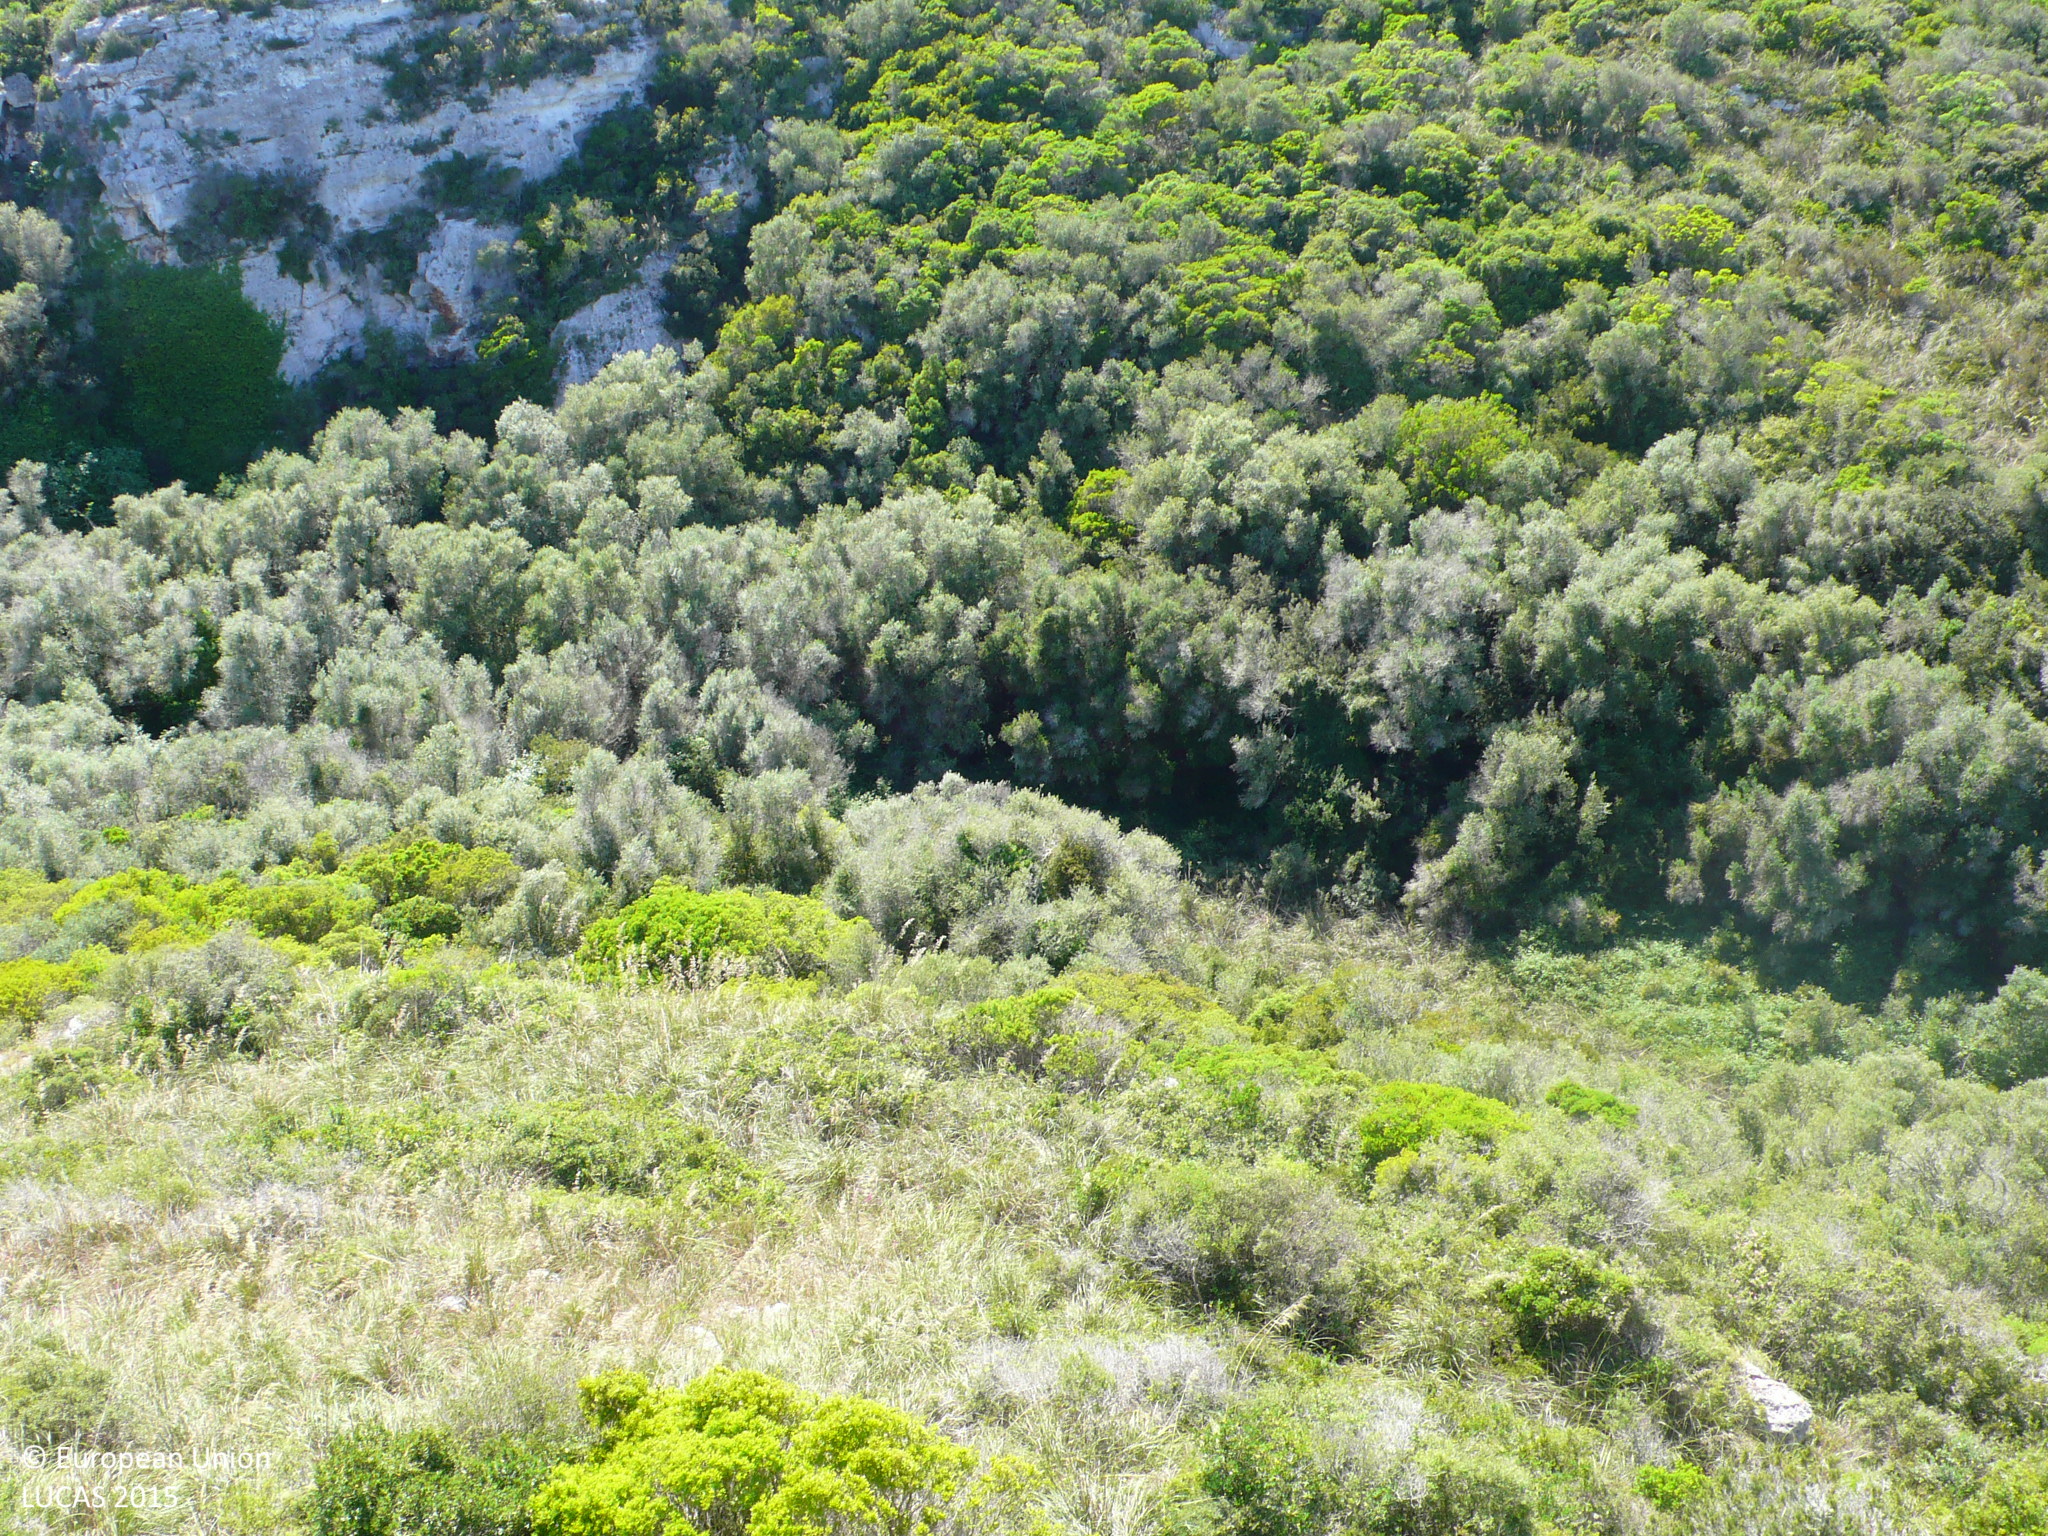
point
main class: Woodland
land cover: Broadleaved woodland
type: broadleaved evergreen forest
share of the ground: 50 - 75 %
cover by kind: broadleaved forest trees 50 %, shrubs 40 %, herbaceous plants 10 %
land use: Semi-natural and natural areas not in use
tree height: > 5 m
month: May
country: ES
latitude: 39.8580
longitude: 4.1702
